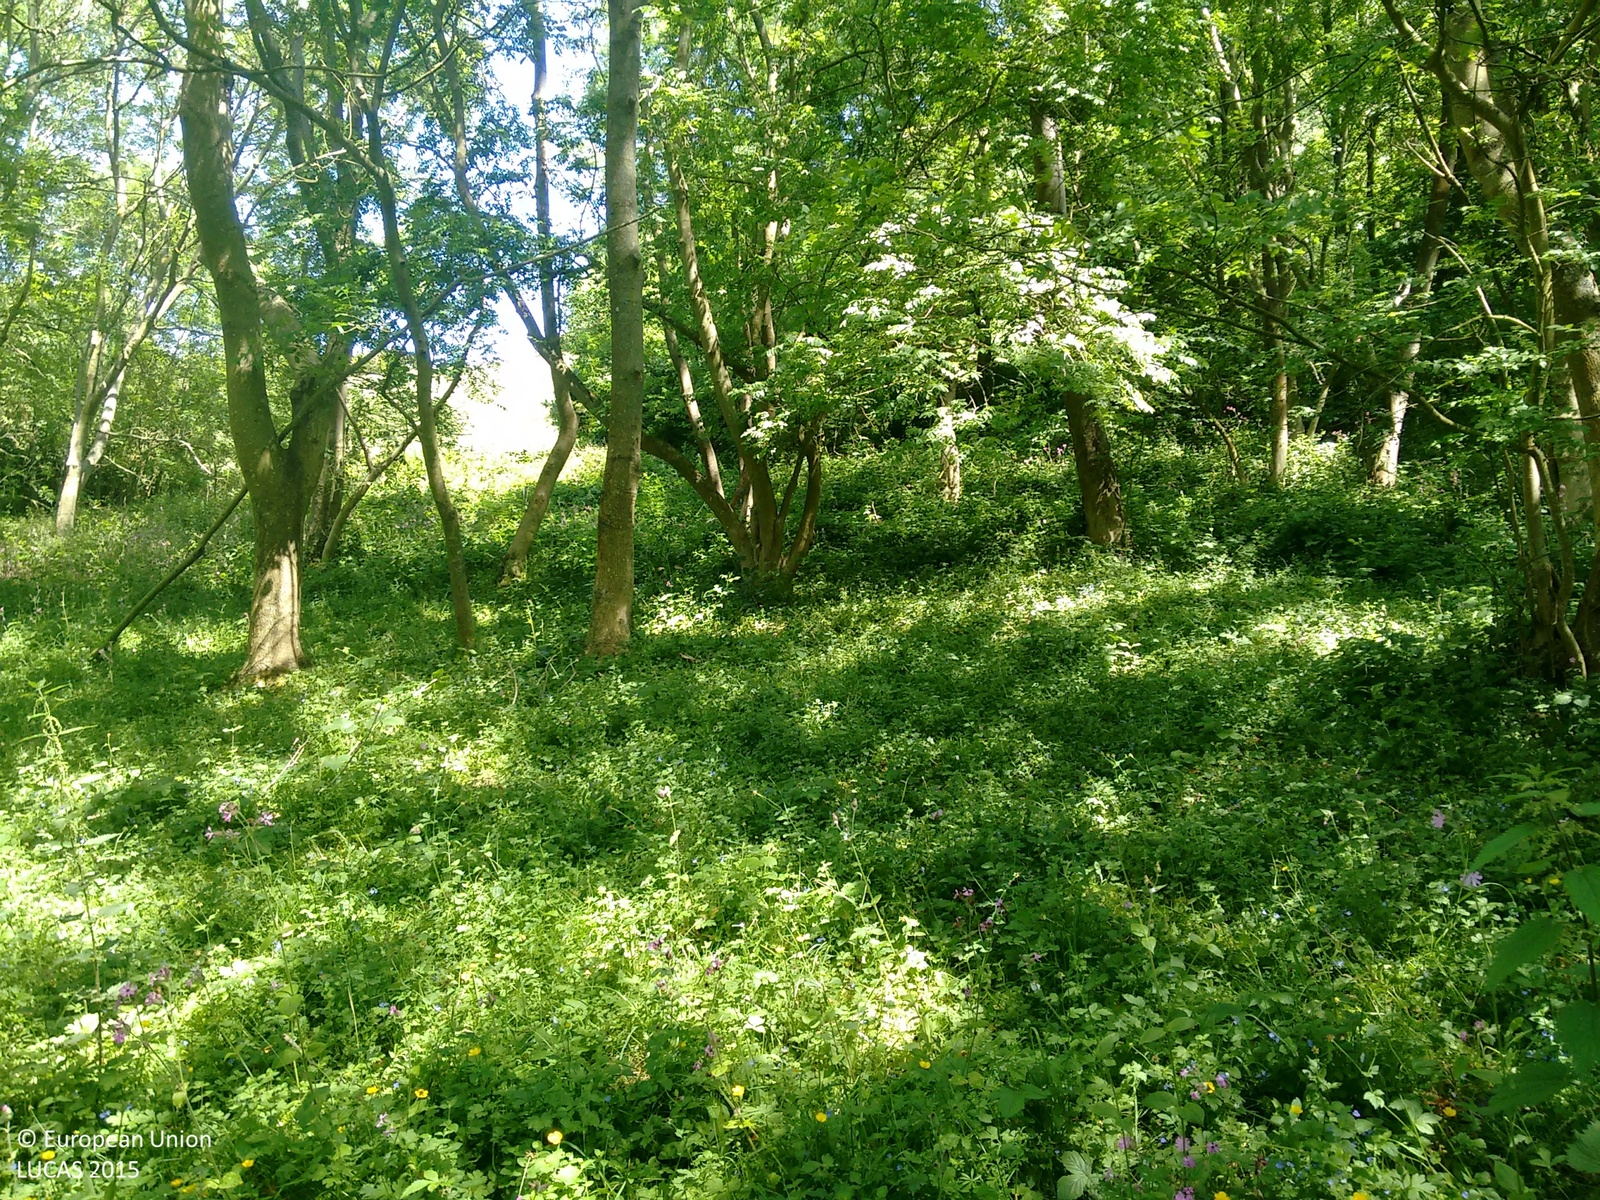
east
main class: Woodland
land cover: Broadleaved woodland
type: mesophytic deciduous forest
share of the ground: > 75 %
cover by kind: broadleaved forest trees 75 %, shrubs 15 %, herbaceous plants 10 %
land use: Semi-natural and natural areas not in use
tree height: > 5 m
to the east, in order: Broadleaved woodland; Fences; Broadleaved woodland; Grassland without tree/shrub cover; Broadleaved woodland; Grassland without tree/shrub cover; Tracks; Grassland without tree/shrub cover; Fences; Grassland without tree/shrub cover
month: June
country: GB
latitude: 50.7956
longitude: 0.2229
